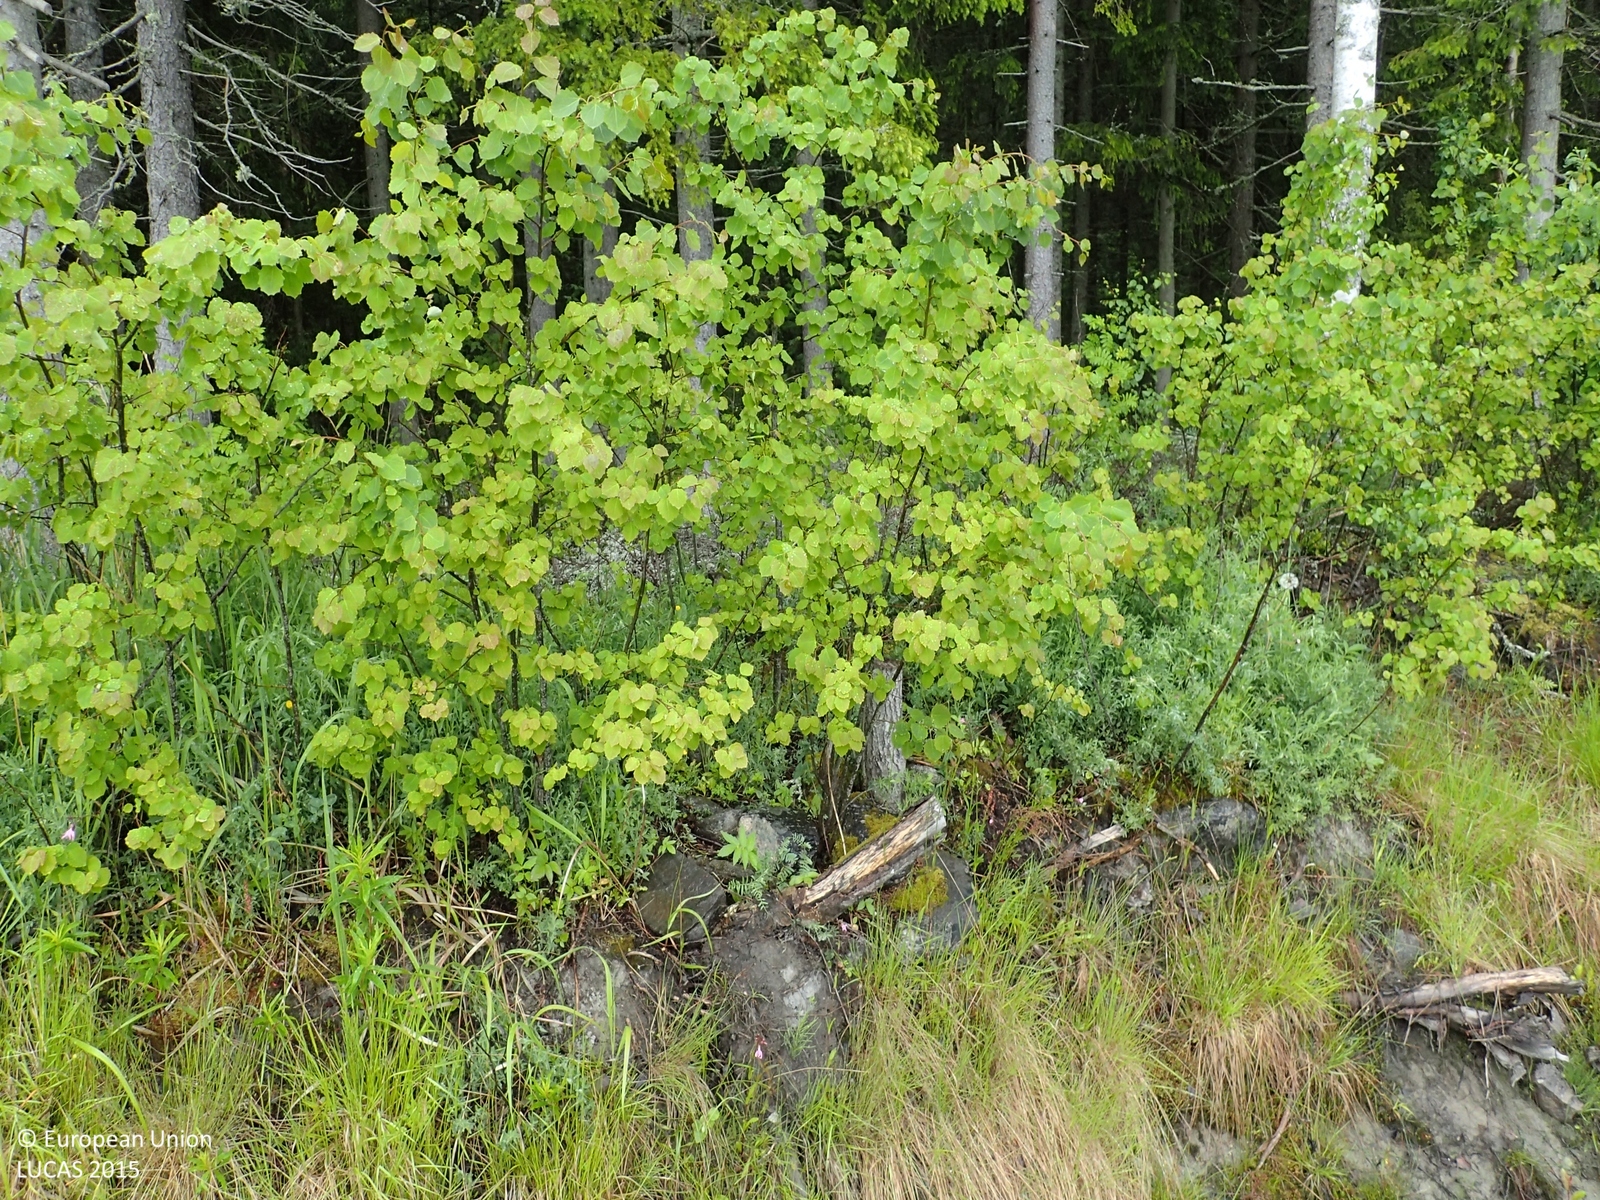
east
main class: Cropland
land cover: Rape and turnip rape
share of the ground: 50 - 75 %
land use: Agriculture (excluding fallow land and kitchen gardens)
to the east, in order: Rape and turnip rape; Shruby margins; Ditches and canals; Abandoned hedges; Spruce dominated coniferous woodland; Other coniferous woodland
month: June
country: FI
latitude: 62.2199
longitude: 21.5664
